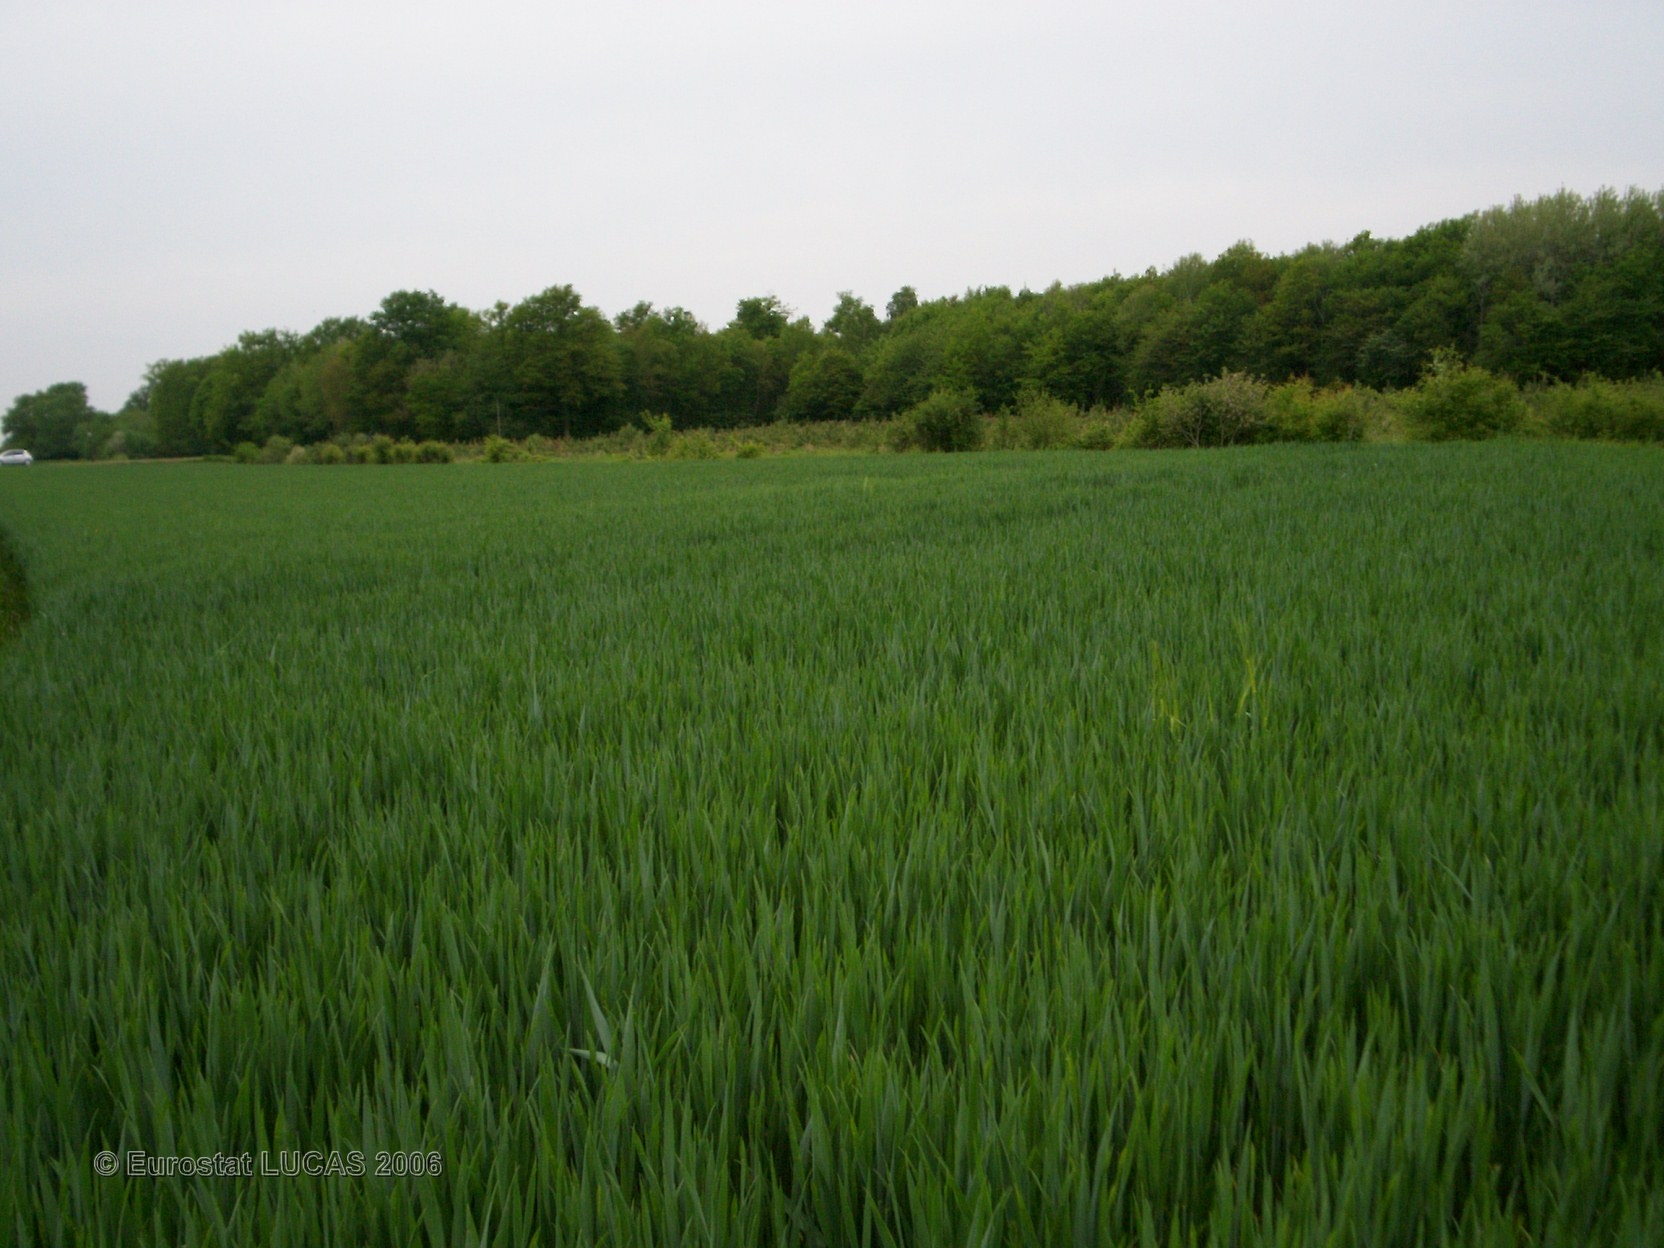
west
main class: Grassland
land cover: Grassland without tree/shrub cover
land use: Agriculture (excluding fallow land and kitchen gardens)
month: May
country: FR
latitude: 47.5768
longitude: 0.4992
